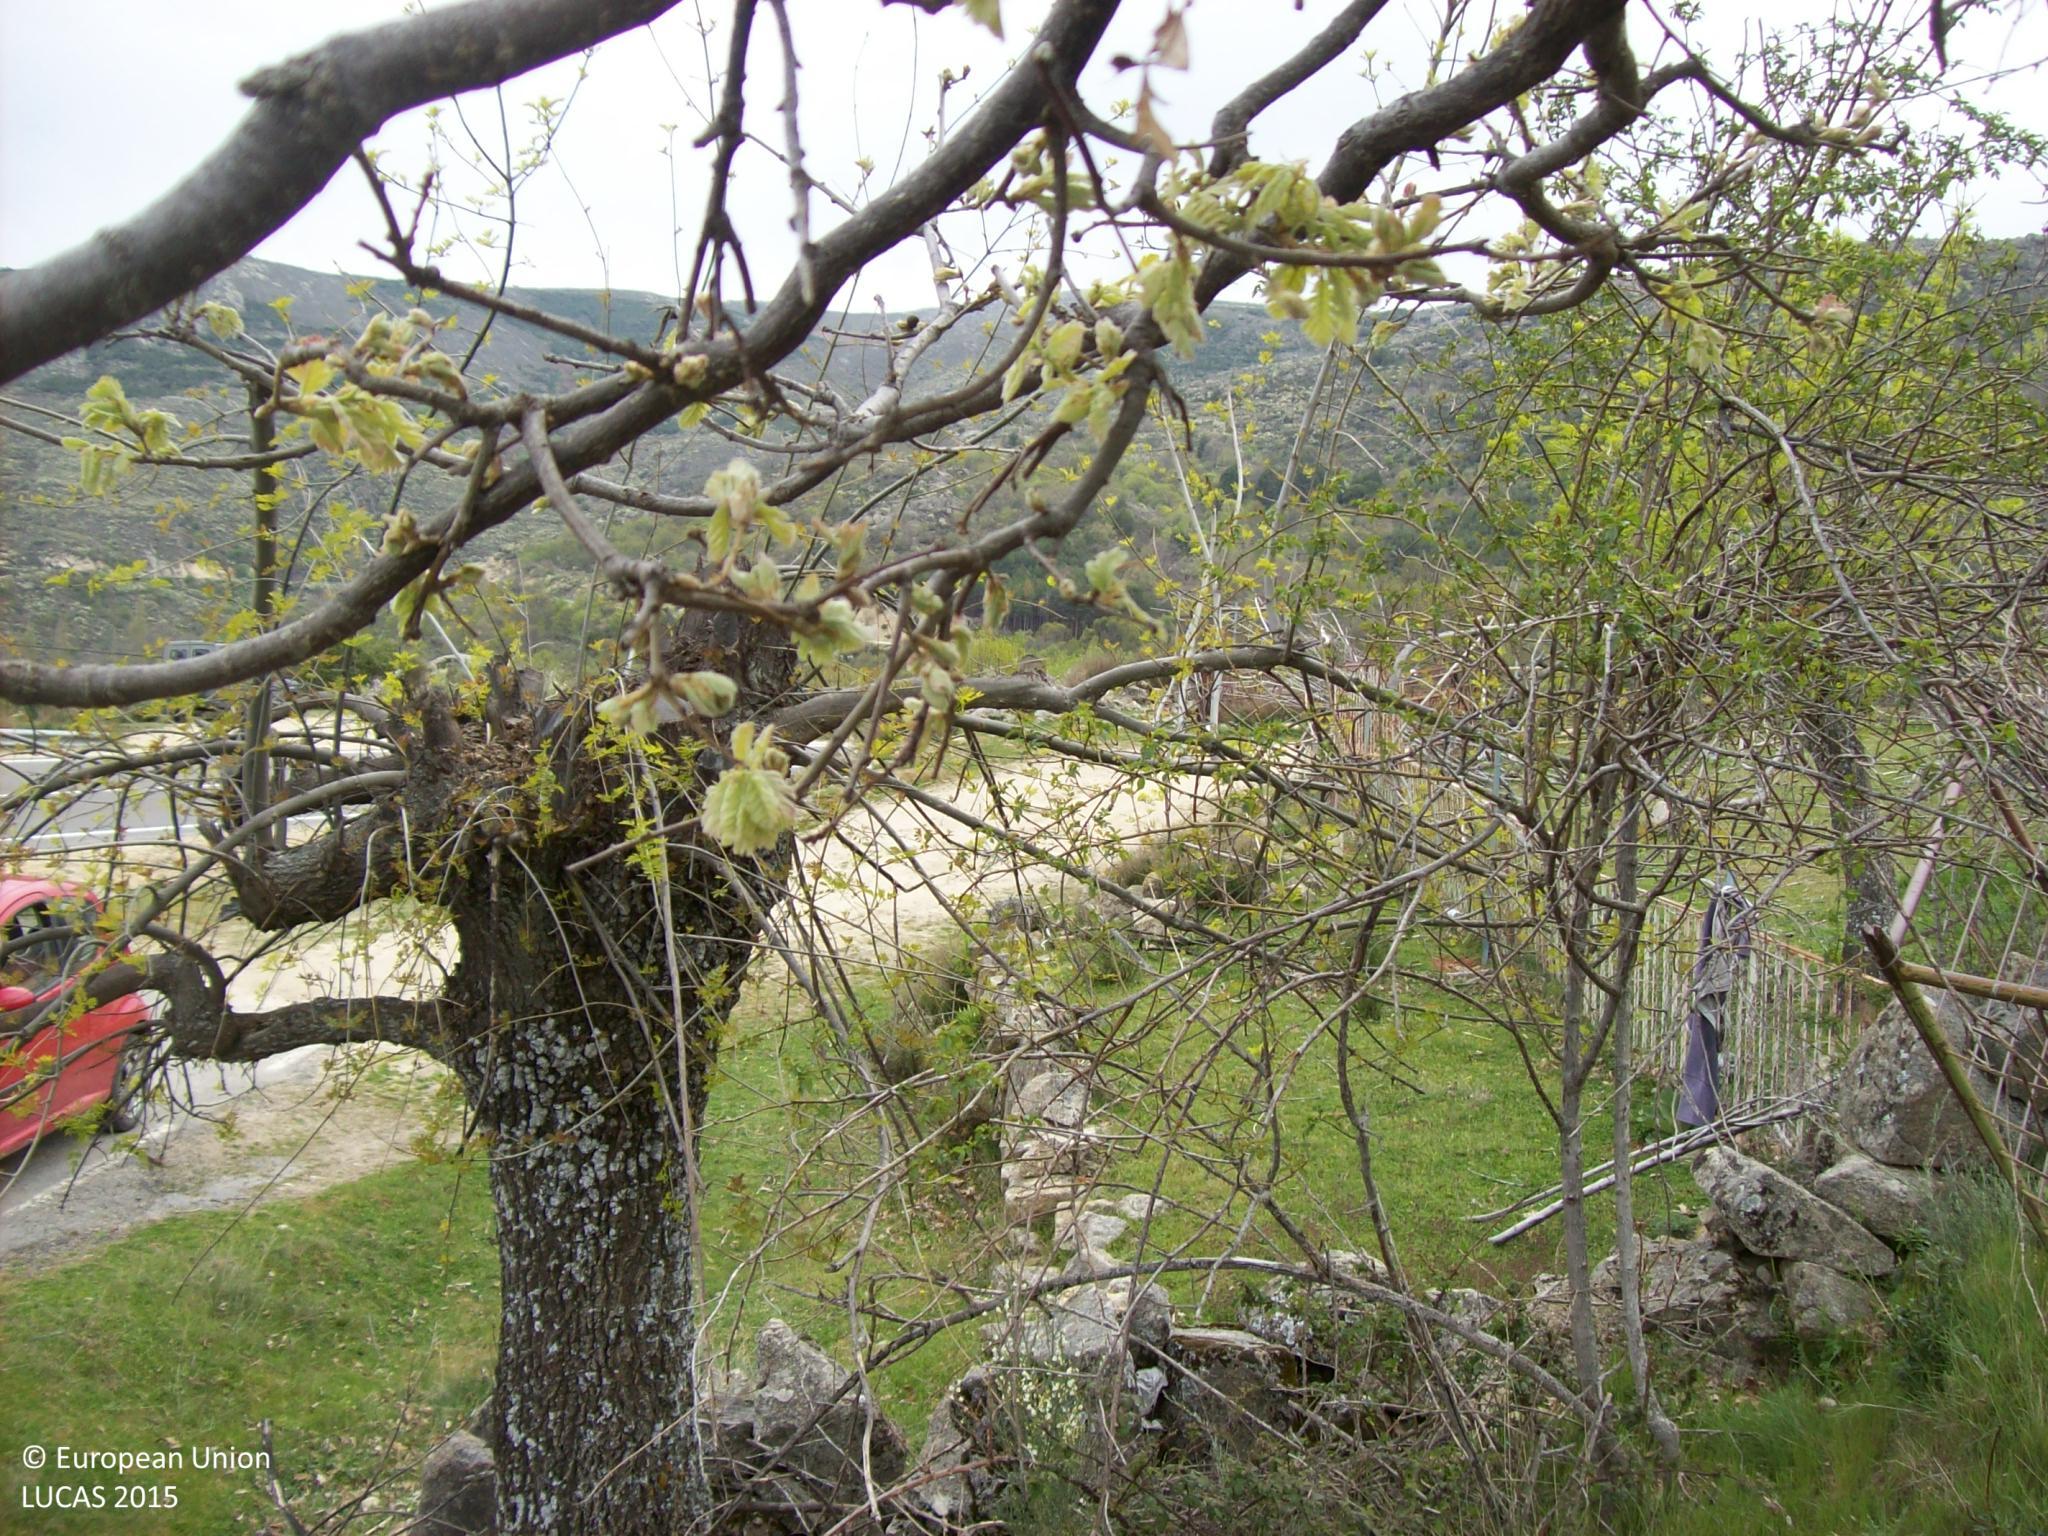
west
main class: Woodland
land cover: Broadleaved woodland
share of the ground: 10 - 25 %
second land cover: Grassland without tree/shrub cover
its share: > 75 %
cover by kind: herbaceous plants 75 %, broadleaved forest trees 25 %
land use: Forestry
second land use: Agriculture (excluding fallow land and kitchen gardens)
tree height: < 5 m
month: April
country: ES
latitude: 40.4089
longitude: -4.8911
